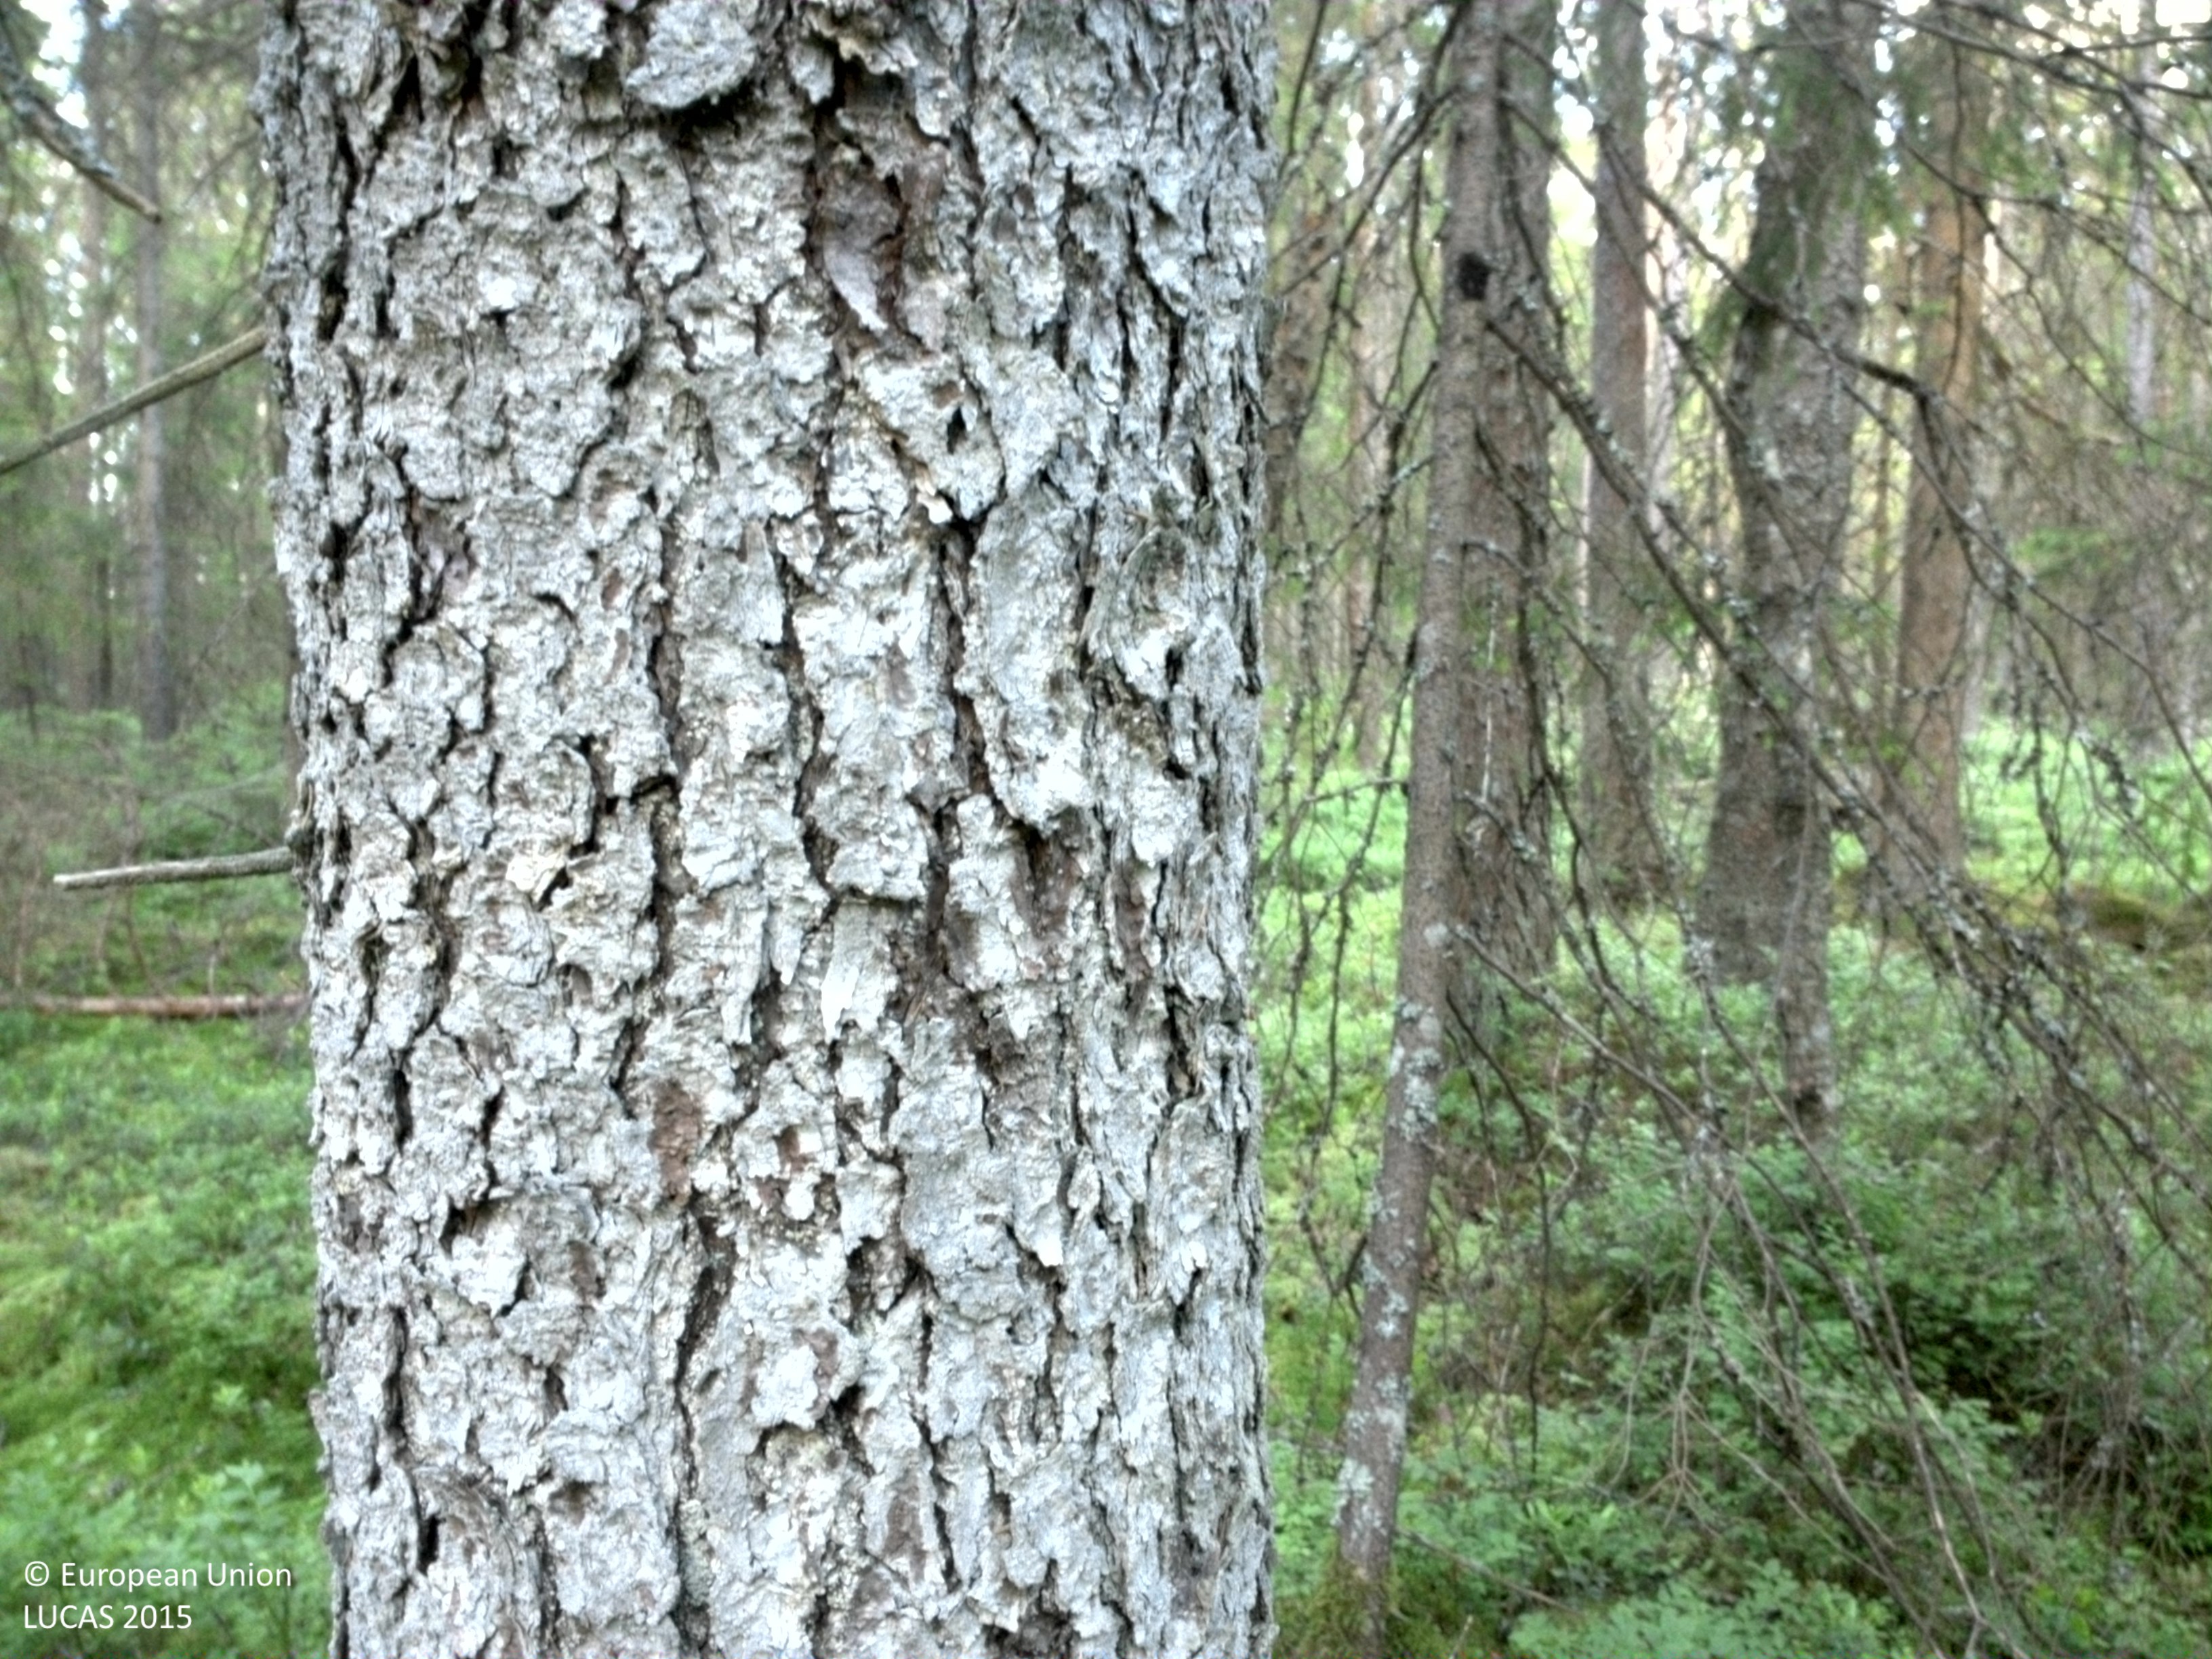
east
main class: Woodland
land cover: Spruce dominated coniferous woodland
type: boreal forest
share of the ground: 50 - 75 %
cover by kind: coniferous forest trees 75 %, lichens and mosses 15 %, shrubs 10 %
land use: Forestry
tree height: > 5 m
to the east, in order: Spruce dominated coniferous woodland; Tracks; Spruce dominated coniferous woodland
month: June
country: SE
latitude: 57.7116
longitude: 13.9395
